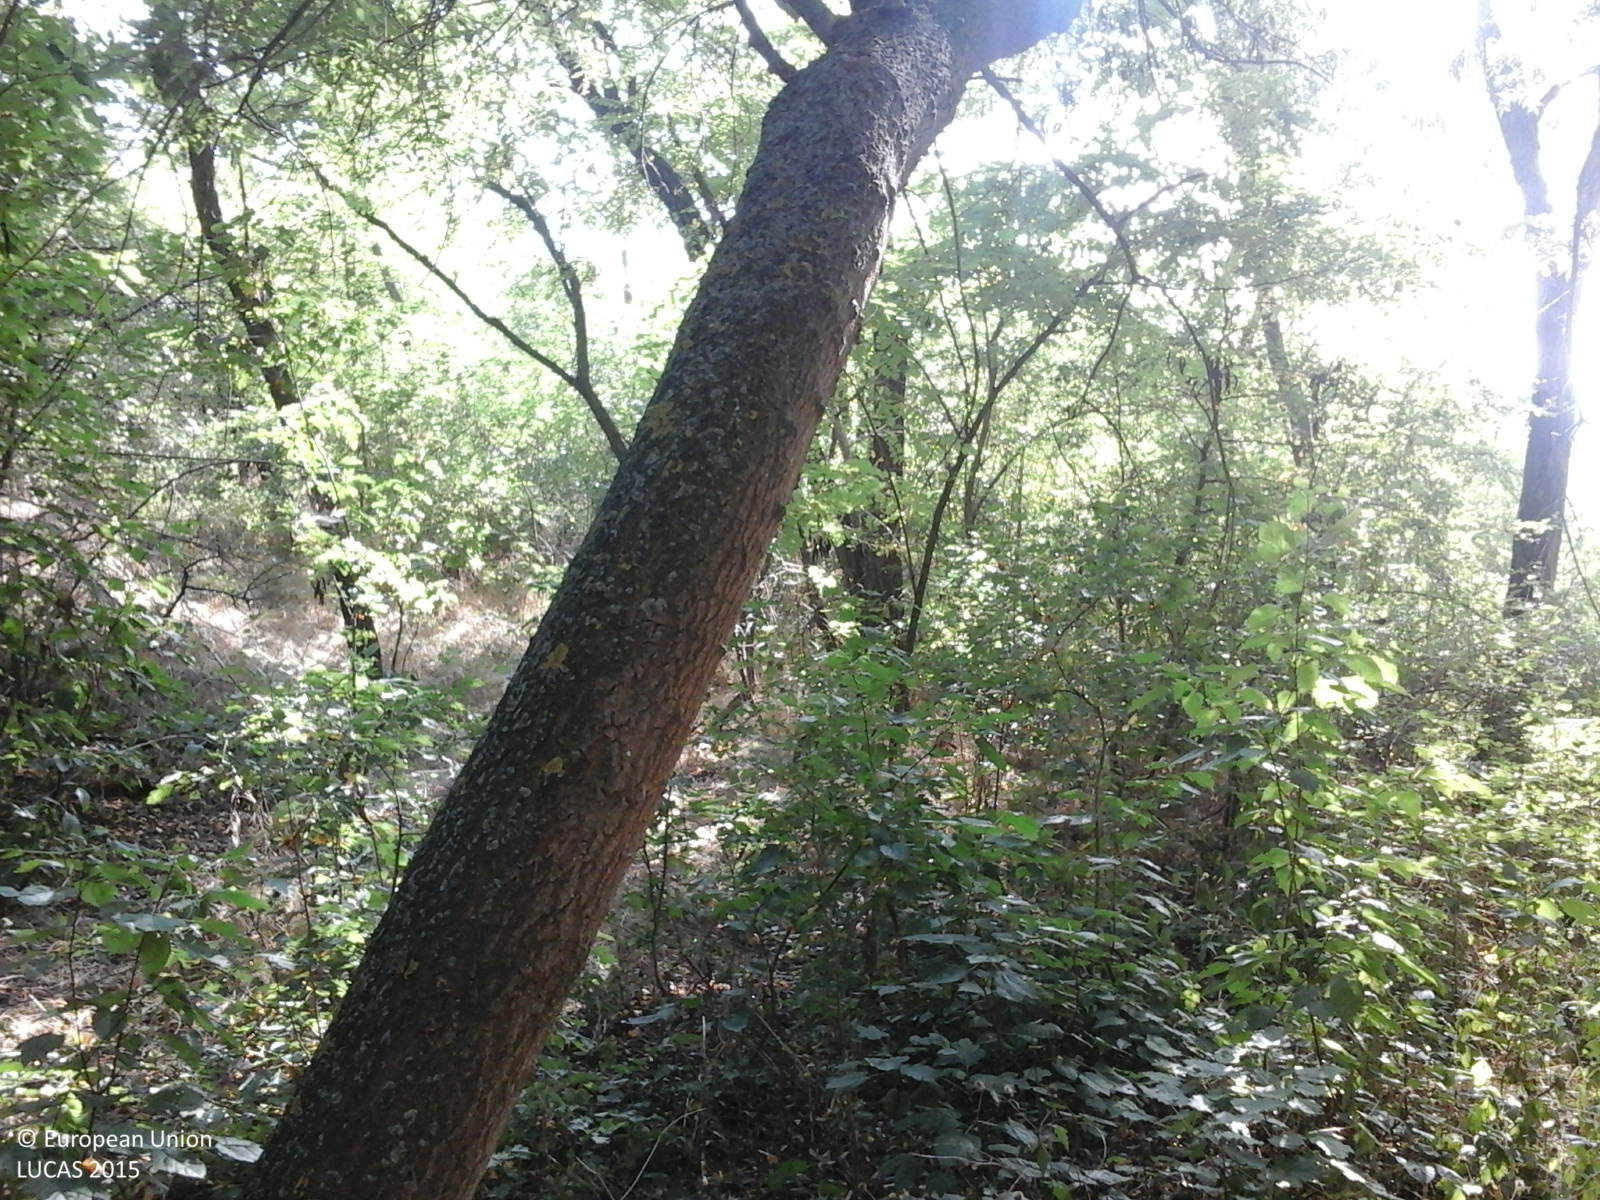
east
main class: Woodland
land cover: Broadleaved woodland
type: mesophytic deciduous forest
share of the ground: > 75 %
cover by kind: broadleaved forest trees 80 %, shrubs 10 %, herbaceous plants 10 %
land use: Forestry
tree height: > 5 m
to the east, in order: Broadleaved woodland; Tracks; Shrubland with sparse tree cover; Grassland without tree/shrub cover; Maize
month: July
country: RO
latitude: 46.1517
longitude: 27.5769
